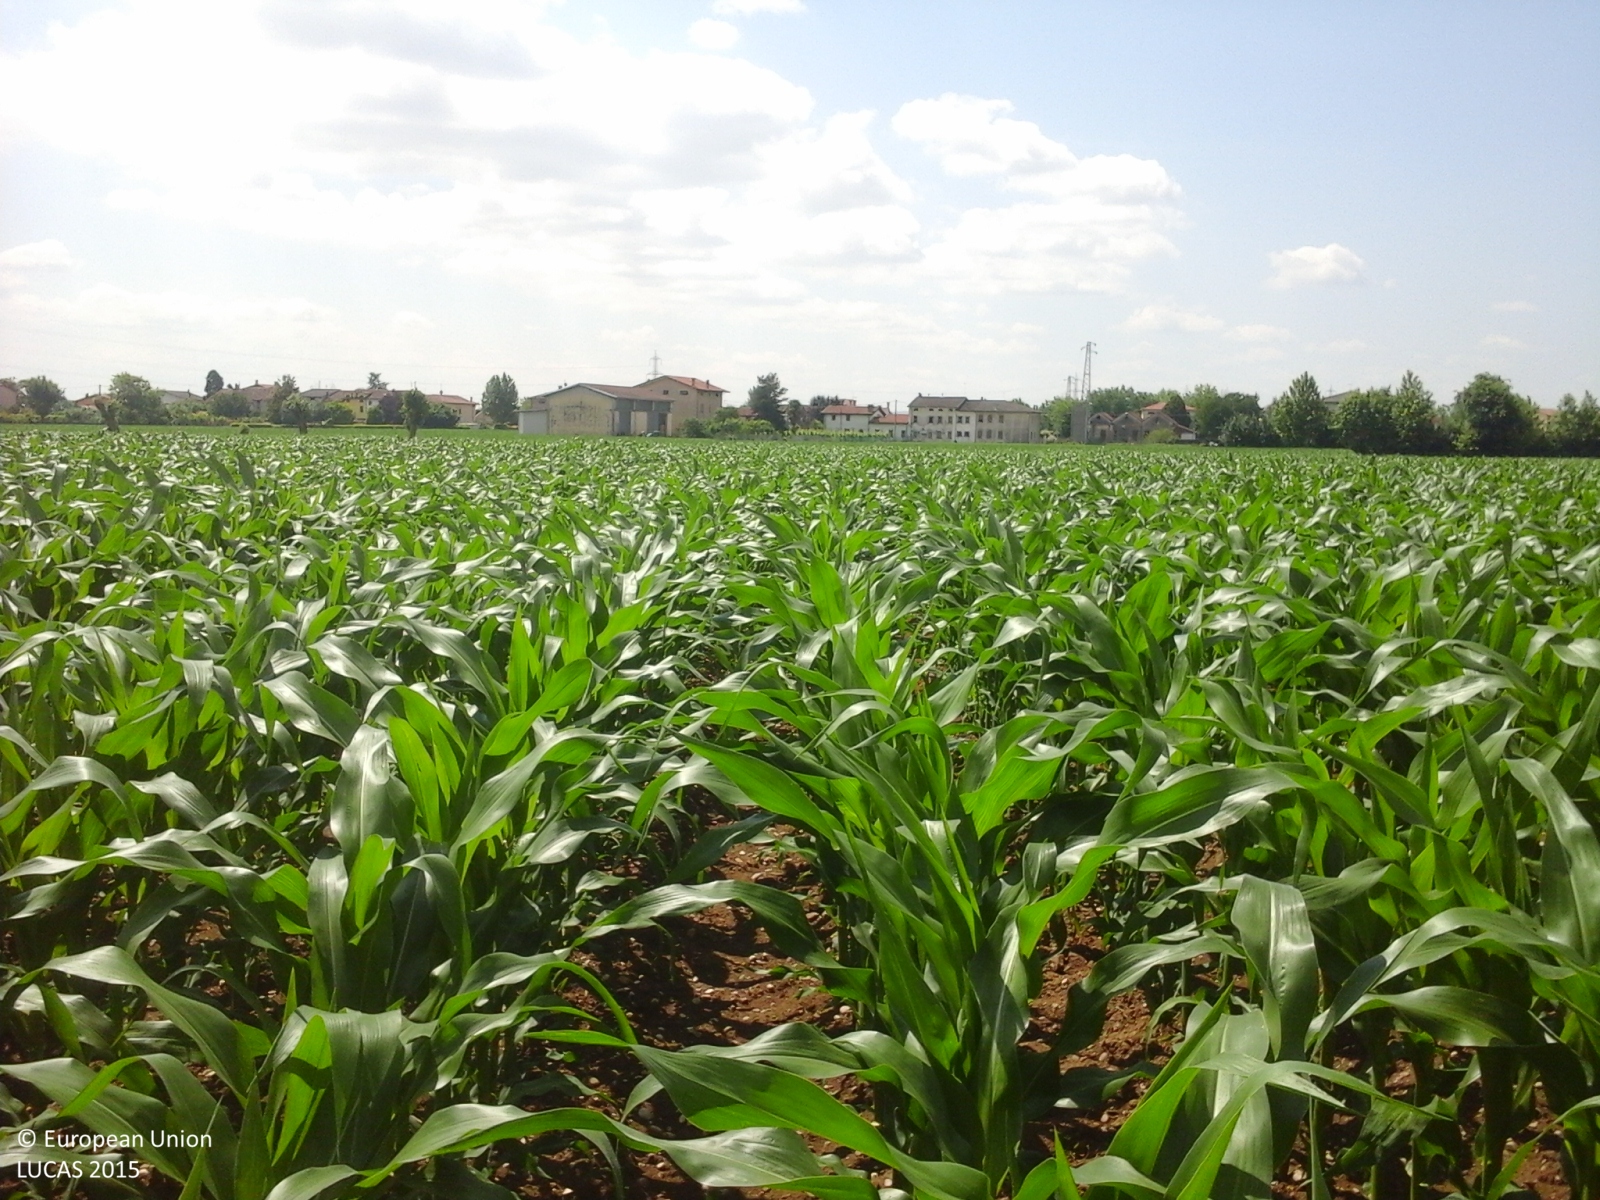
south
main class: Cropland
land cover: Maize
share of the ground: > 75 %
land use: Agriculture (excluding fallow land and kitchen gardens)
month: May
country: IT
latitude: 45.6545
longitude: 11.6016
